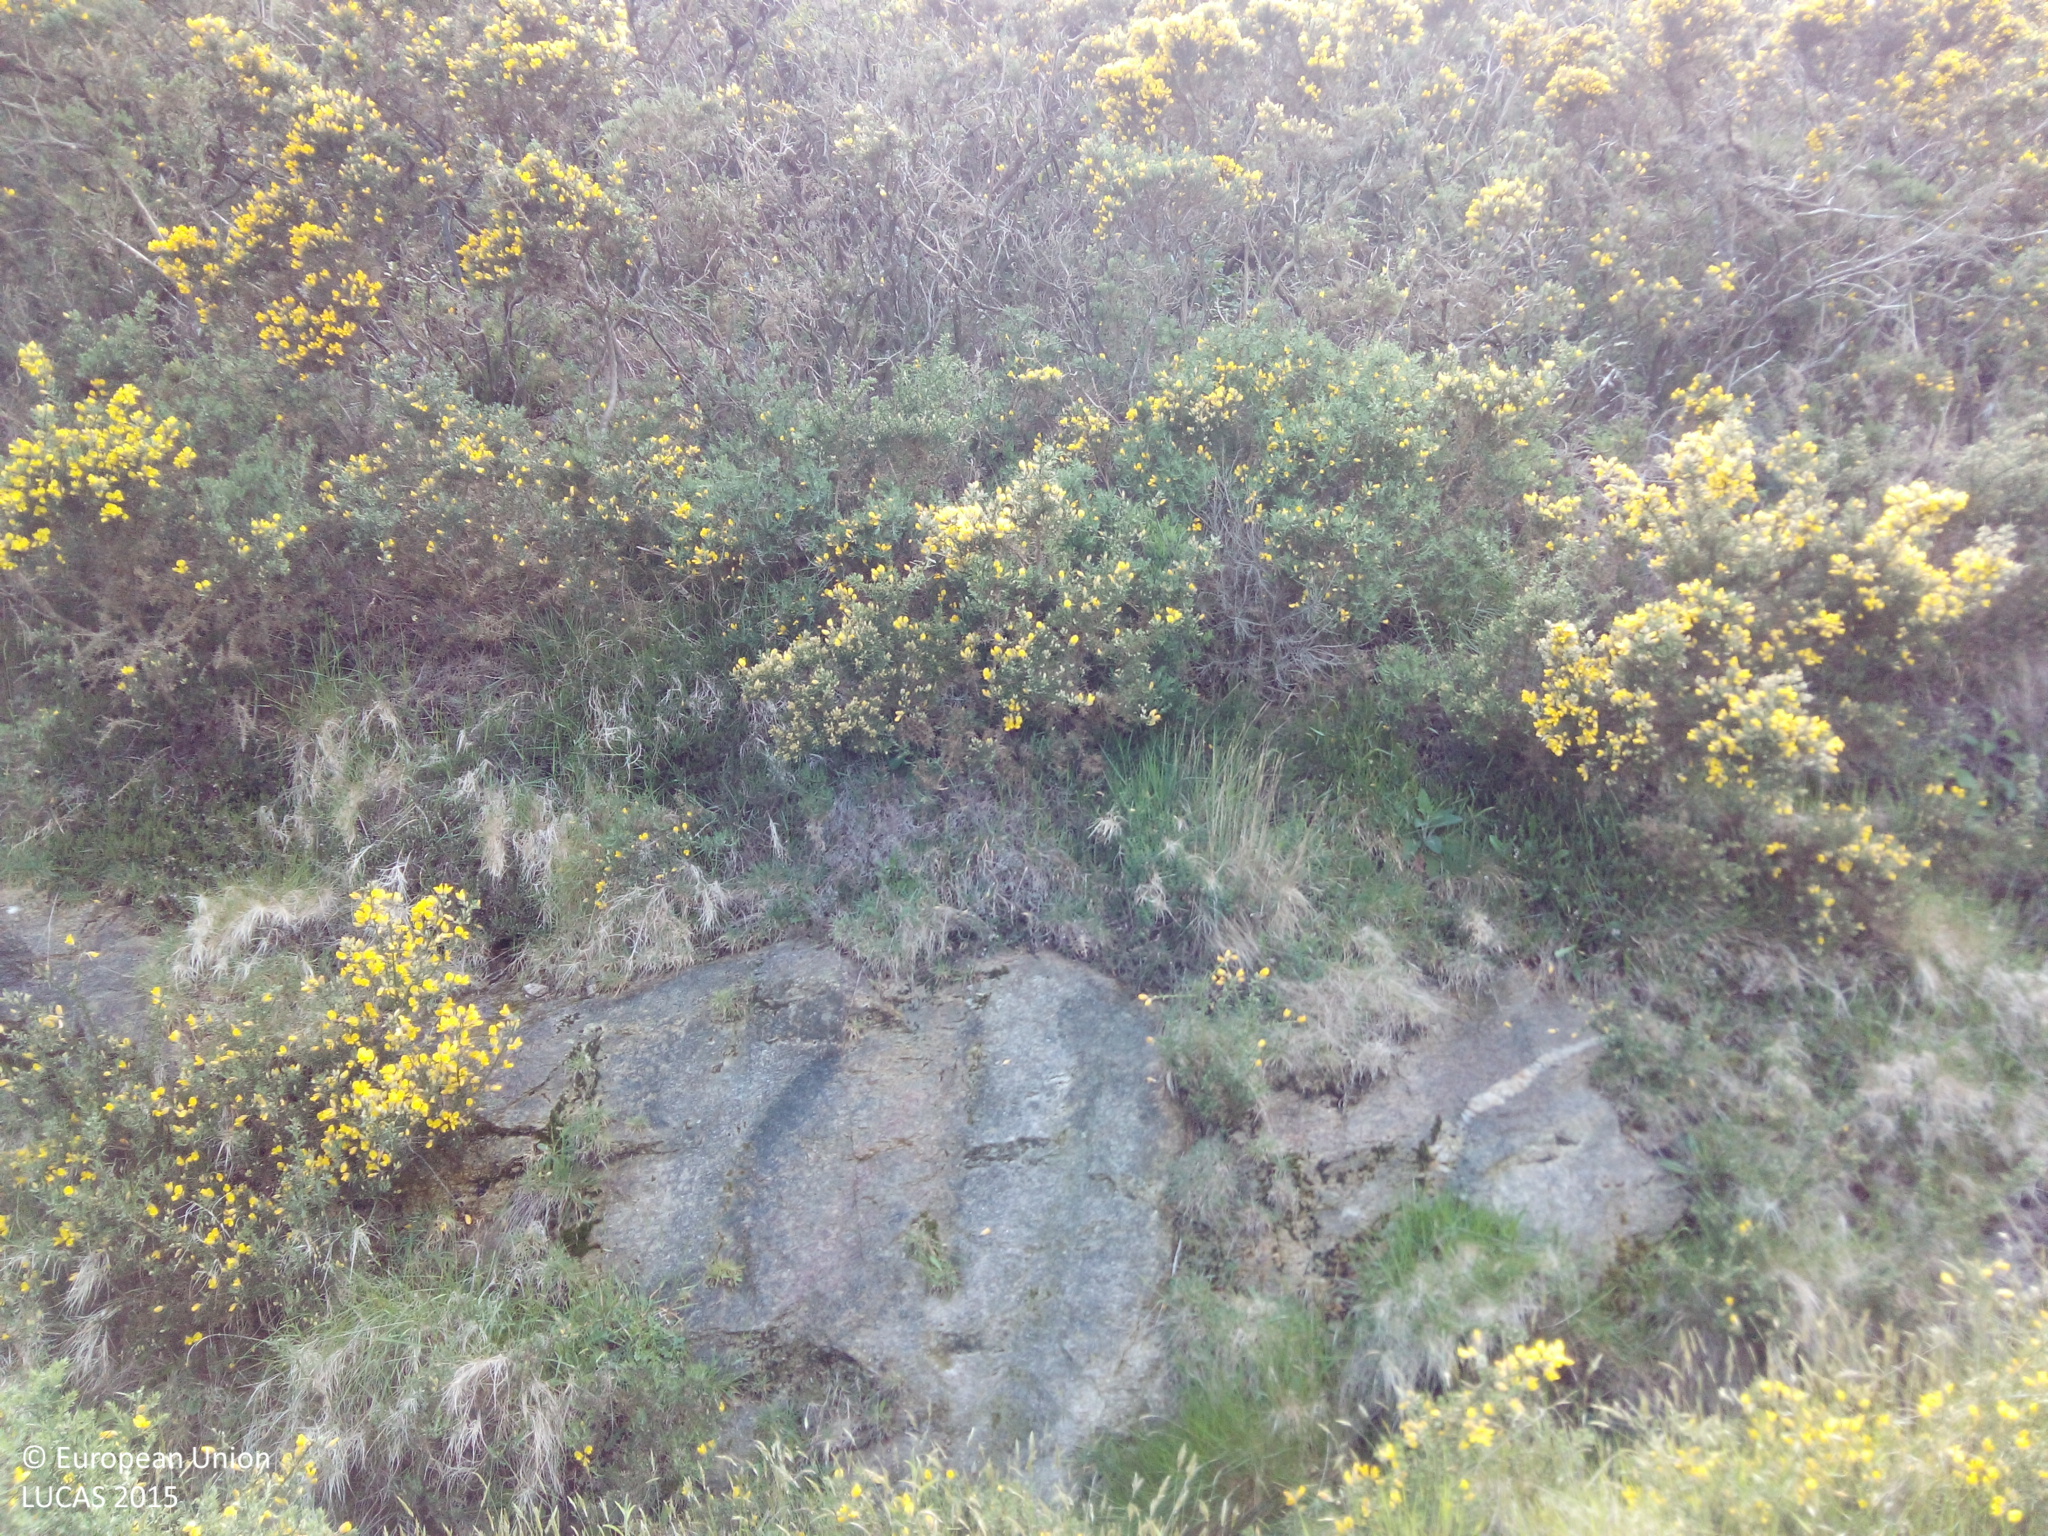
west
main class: Woodland
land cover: Pine dominated coniferous woodland
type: hemiboreal forest and nemoral coniferous forest and mixed broadleaved-coniferous forest
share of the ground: > 75 %
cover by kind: coniferous forest trees 75 %, shrubs 25 %
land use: Forestry
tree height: > 5 m
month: May
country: ES
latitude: 42.8256
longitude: -9.0434
